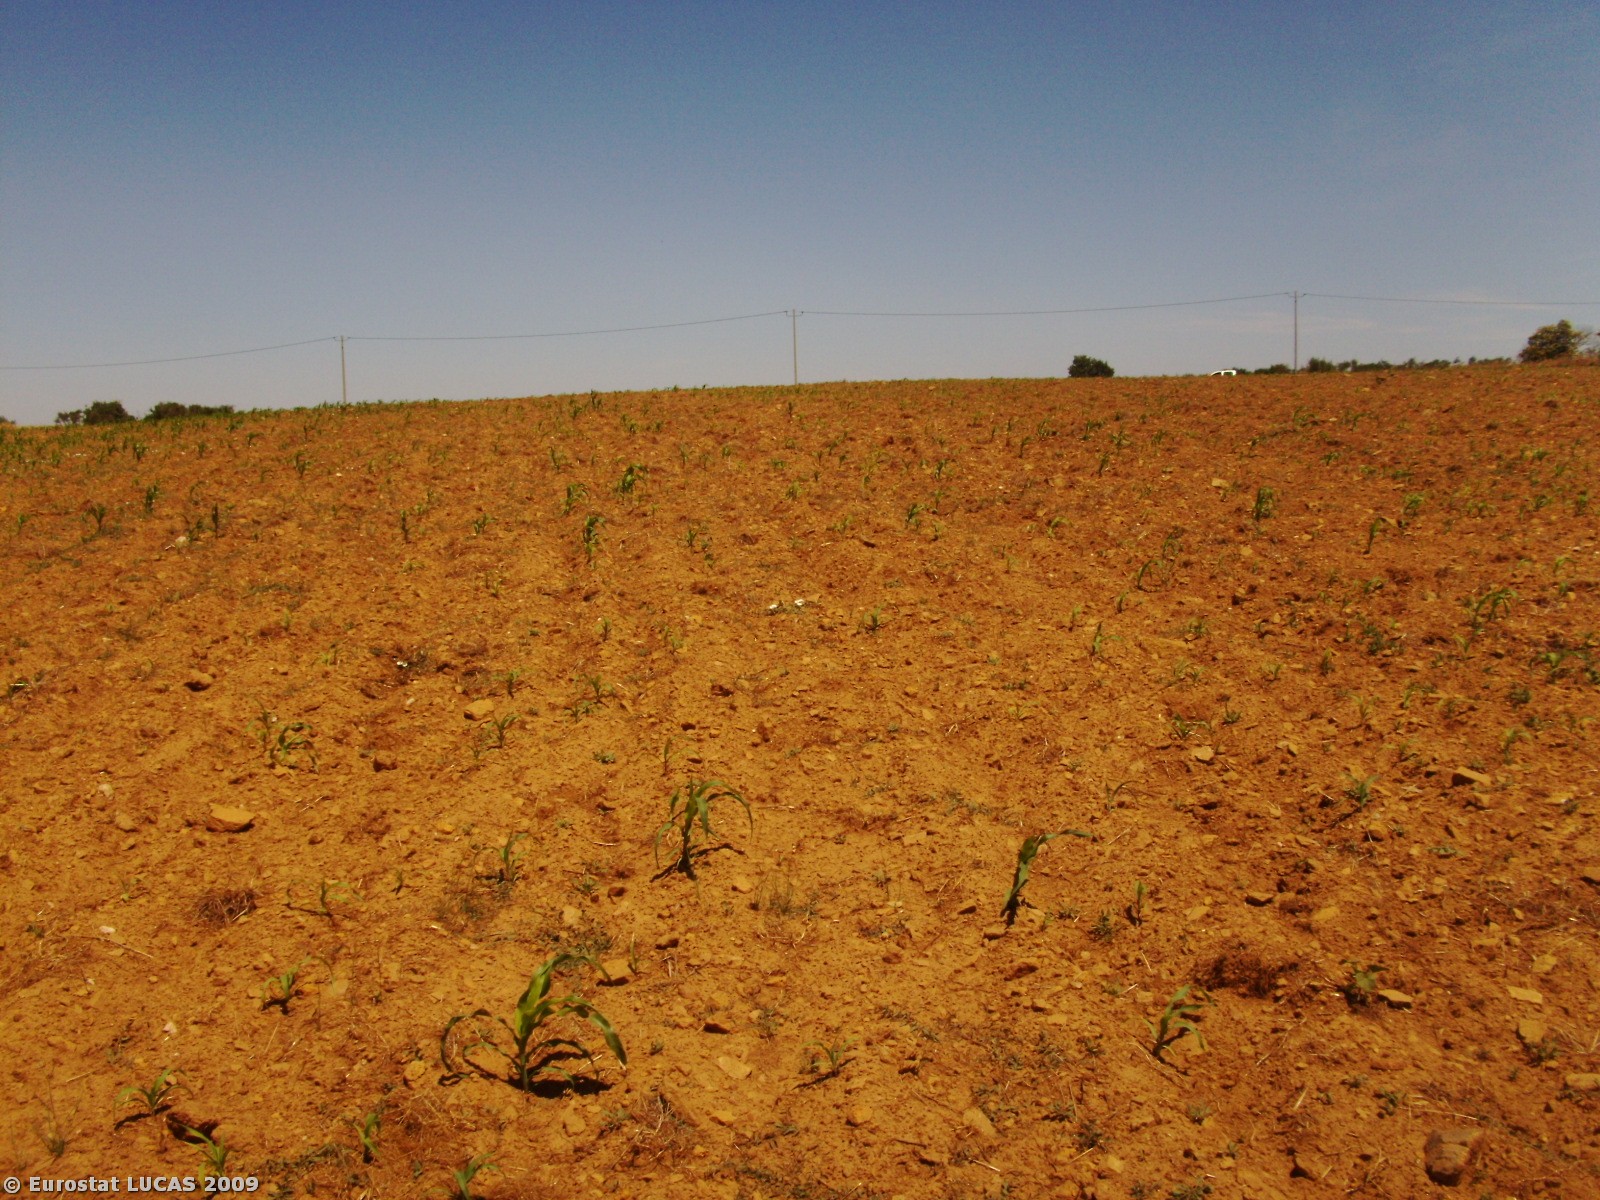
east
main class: Cropland
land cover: Maize
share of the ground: 10 - 25 %
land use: Agriculture (excluding fallow land and kitchen gardens)
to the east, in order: Maize; Spontaneously vegetated surfaces; Paved roads, cycling and walking lanes; Electric lines; Spontaneously vegetated surfaces
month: July
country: PT
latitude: 40.3501
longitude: -7.0395
